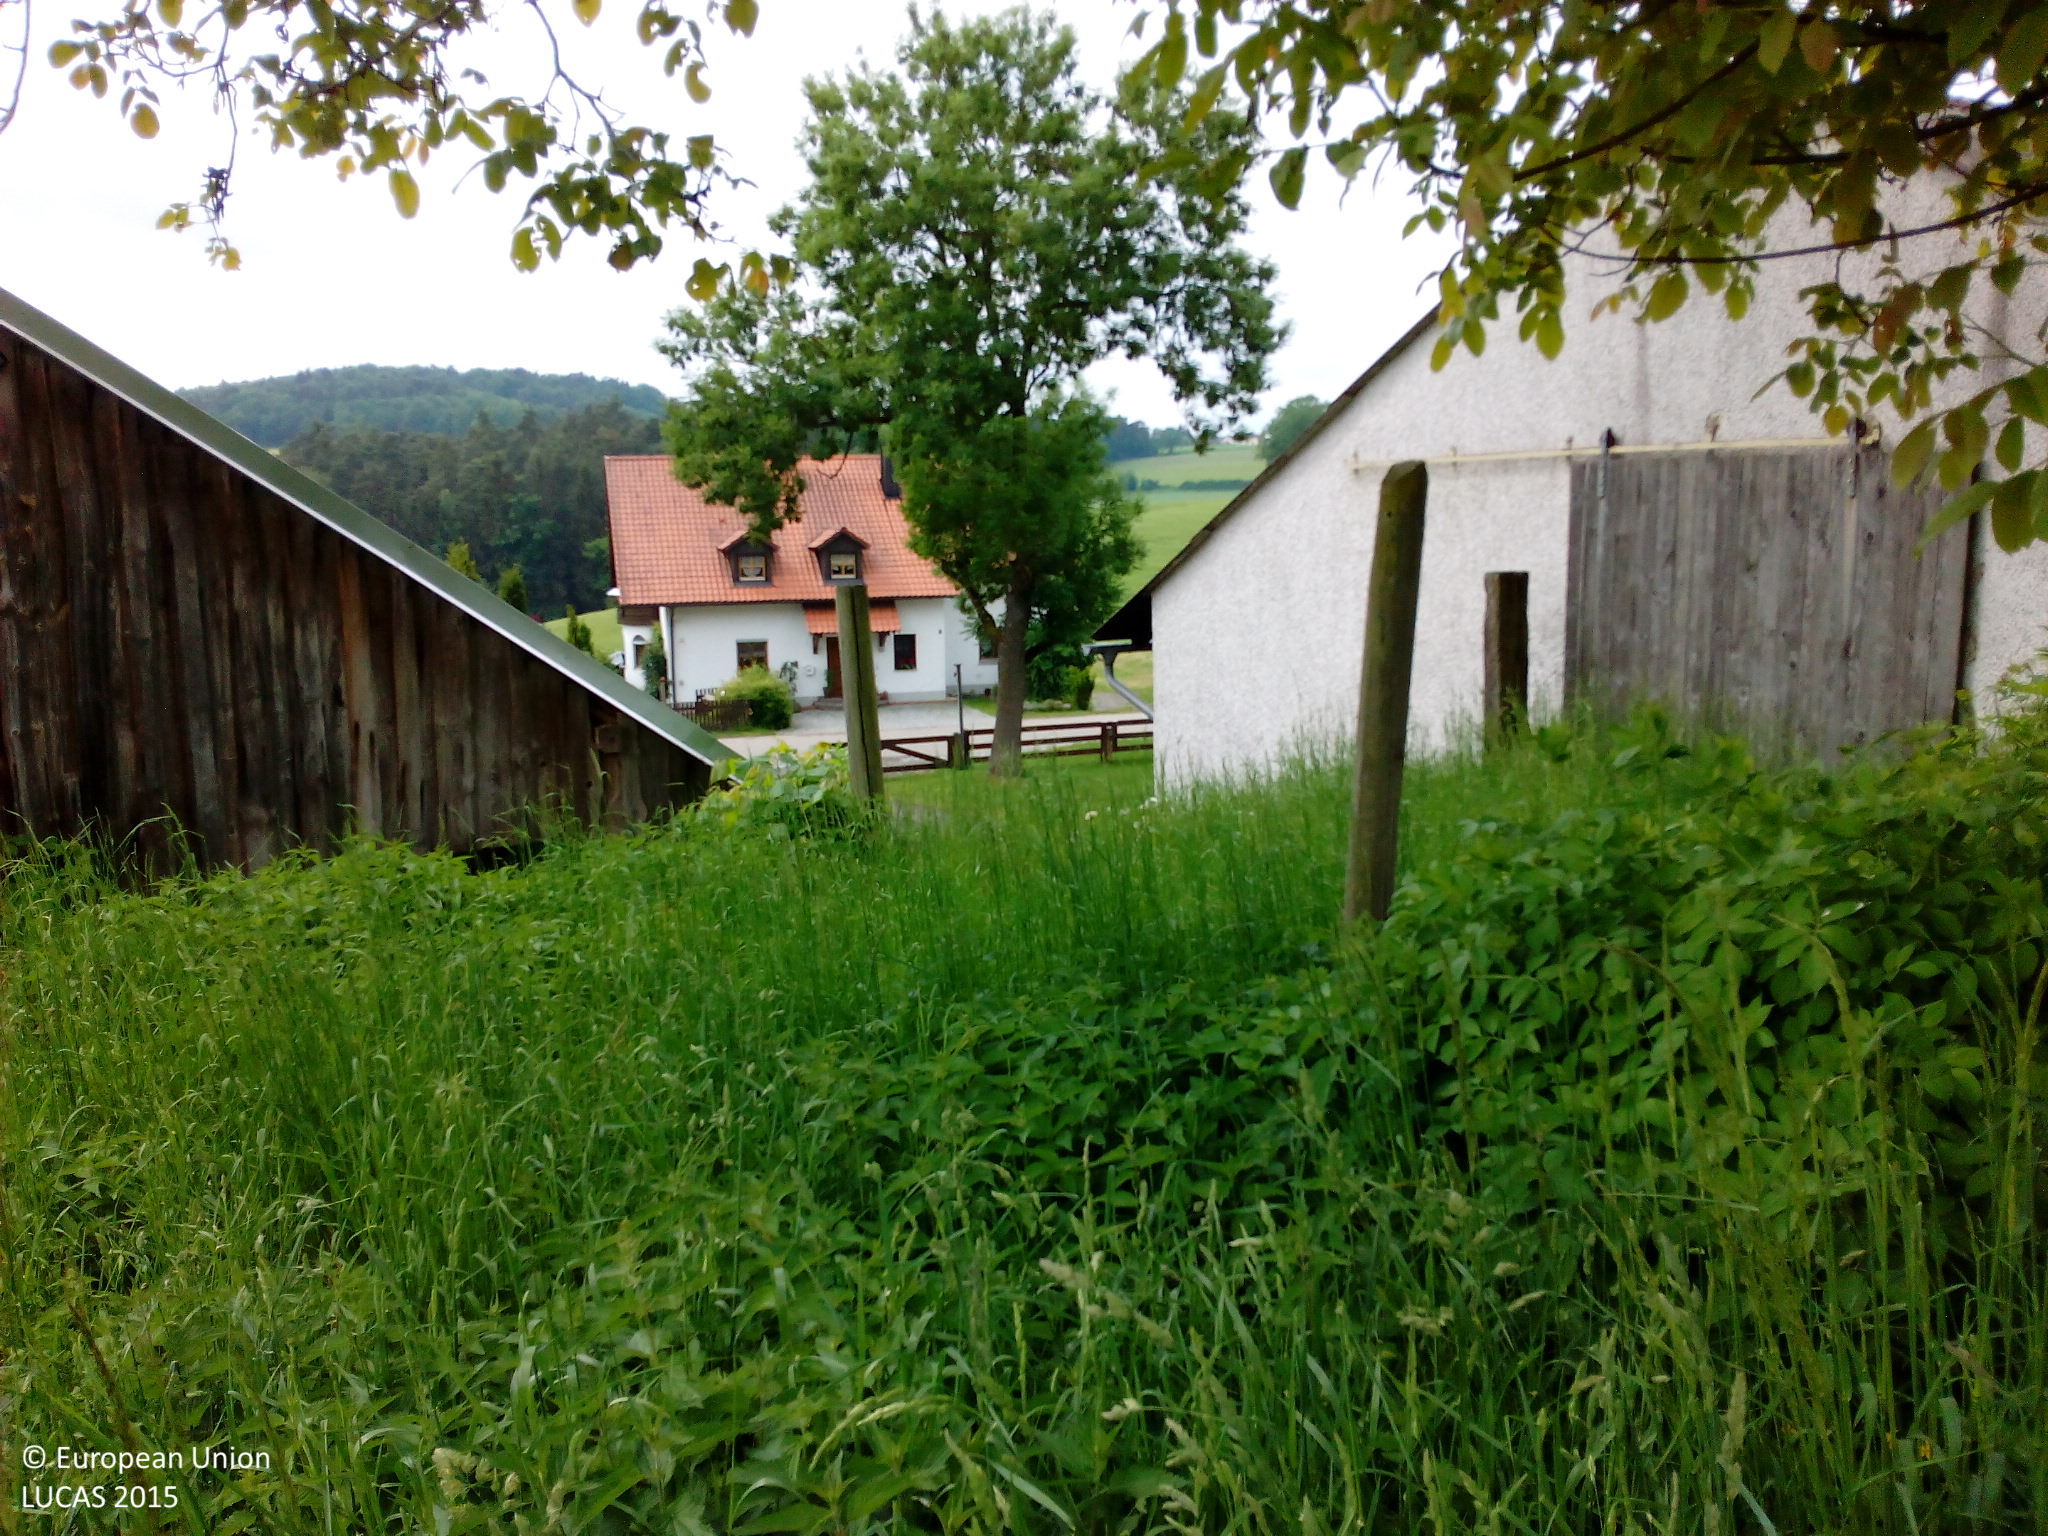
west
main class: Cropland
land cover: Rye
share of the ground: > 75 %
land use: Agriculture (excluding fallow land and kitchen gardens)
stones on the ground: < 10 %
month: May
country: DE
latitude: 49.1189
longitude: 12.2328
